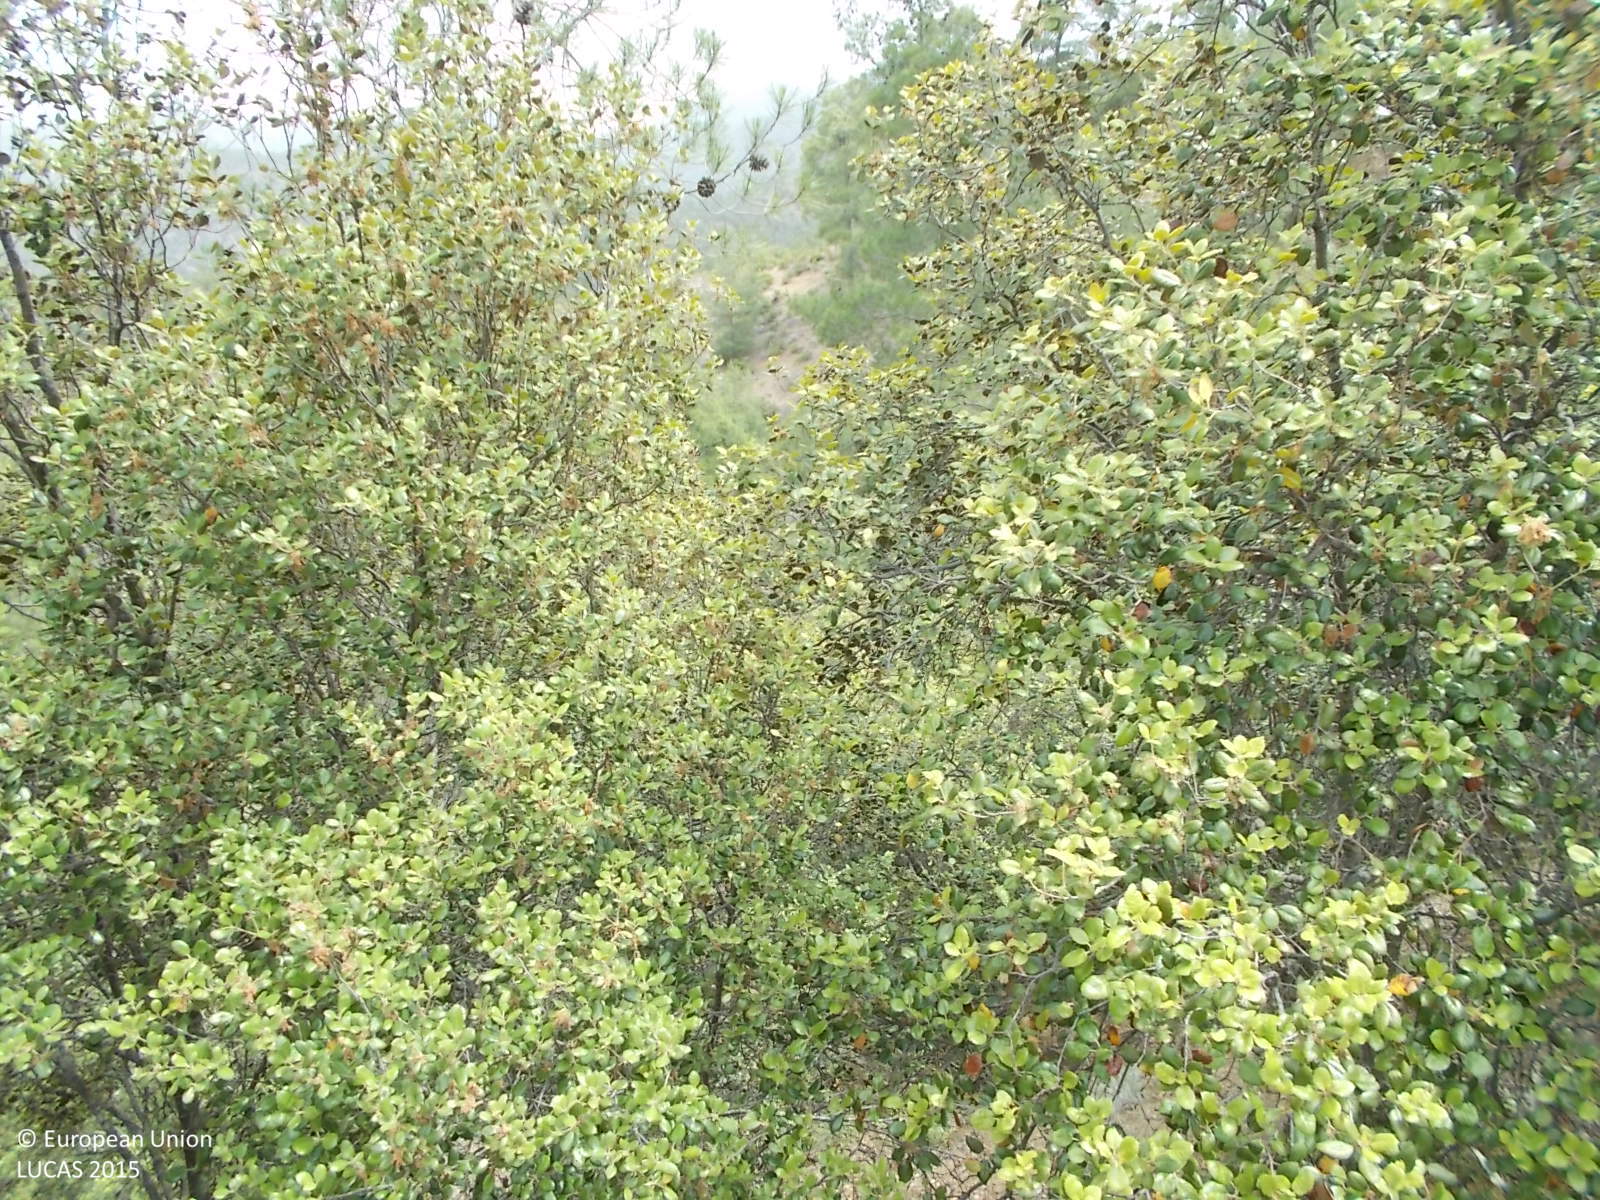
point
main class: Woodland
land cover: Broadleaved woodland
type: broadleaved evergreen forest
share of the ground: > 75 %
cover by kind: broadleaved forest trees 90 %, coniferous forest trees 10 %
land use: Forestry
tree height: > 5 m
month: May
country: CY
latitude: 34.9876
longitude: 32.6054
